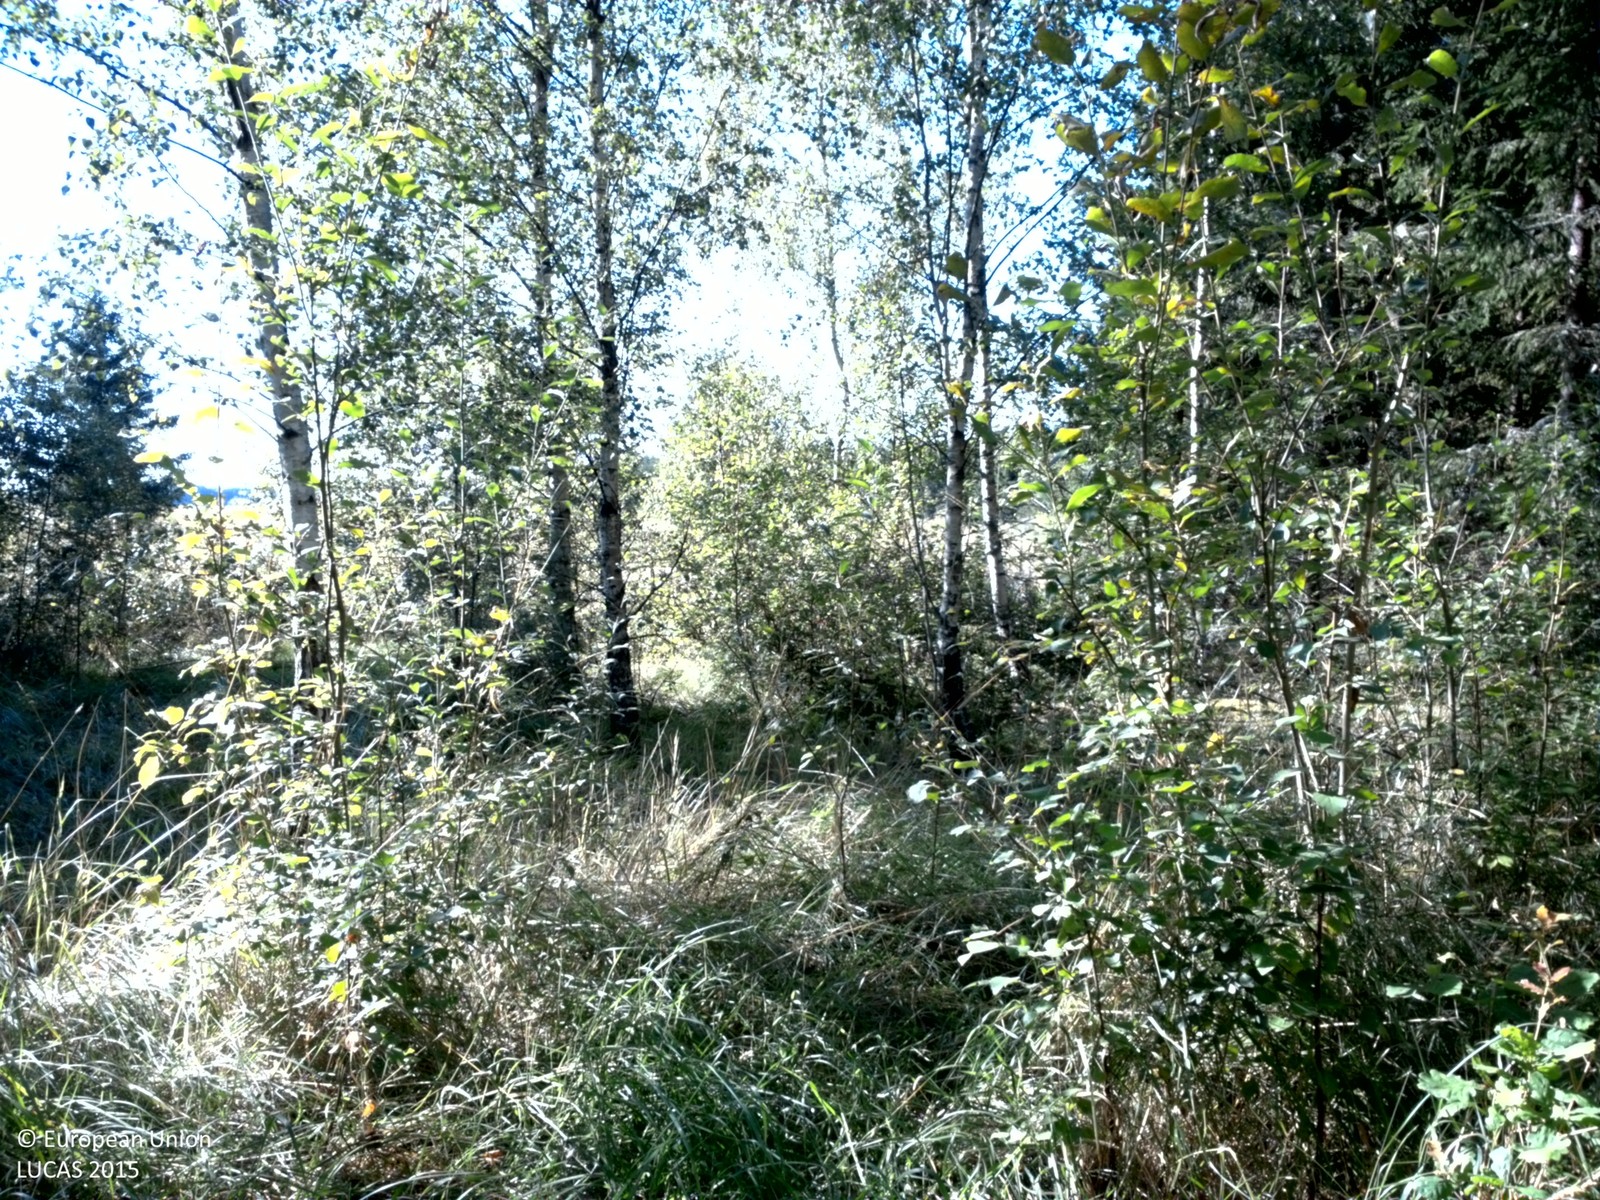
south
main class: Woodland
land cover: Broadleaved woodland
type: boreal forest
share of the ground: 50 - 75 %
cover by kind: broadleaved forest trees 60 %, herbaceous plants 40 %
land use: Forestry
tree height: > 5 m
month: August
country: SE
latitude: 59.8773
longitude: 16.6905
